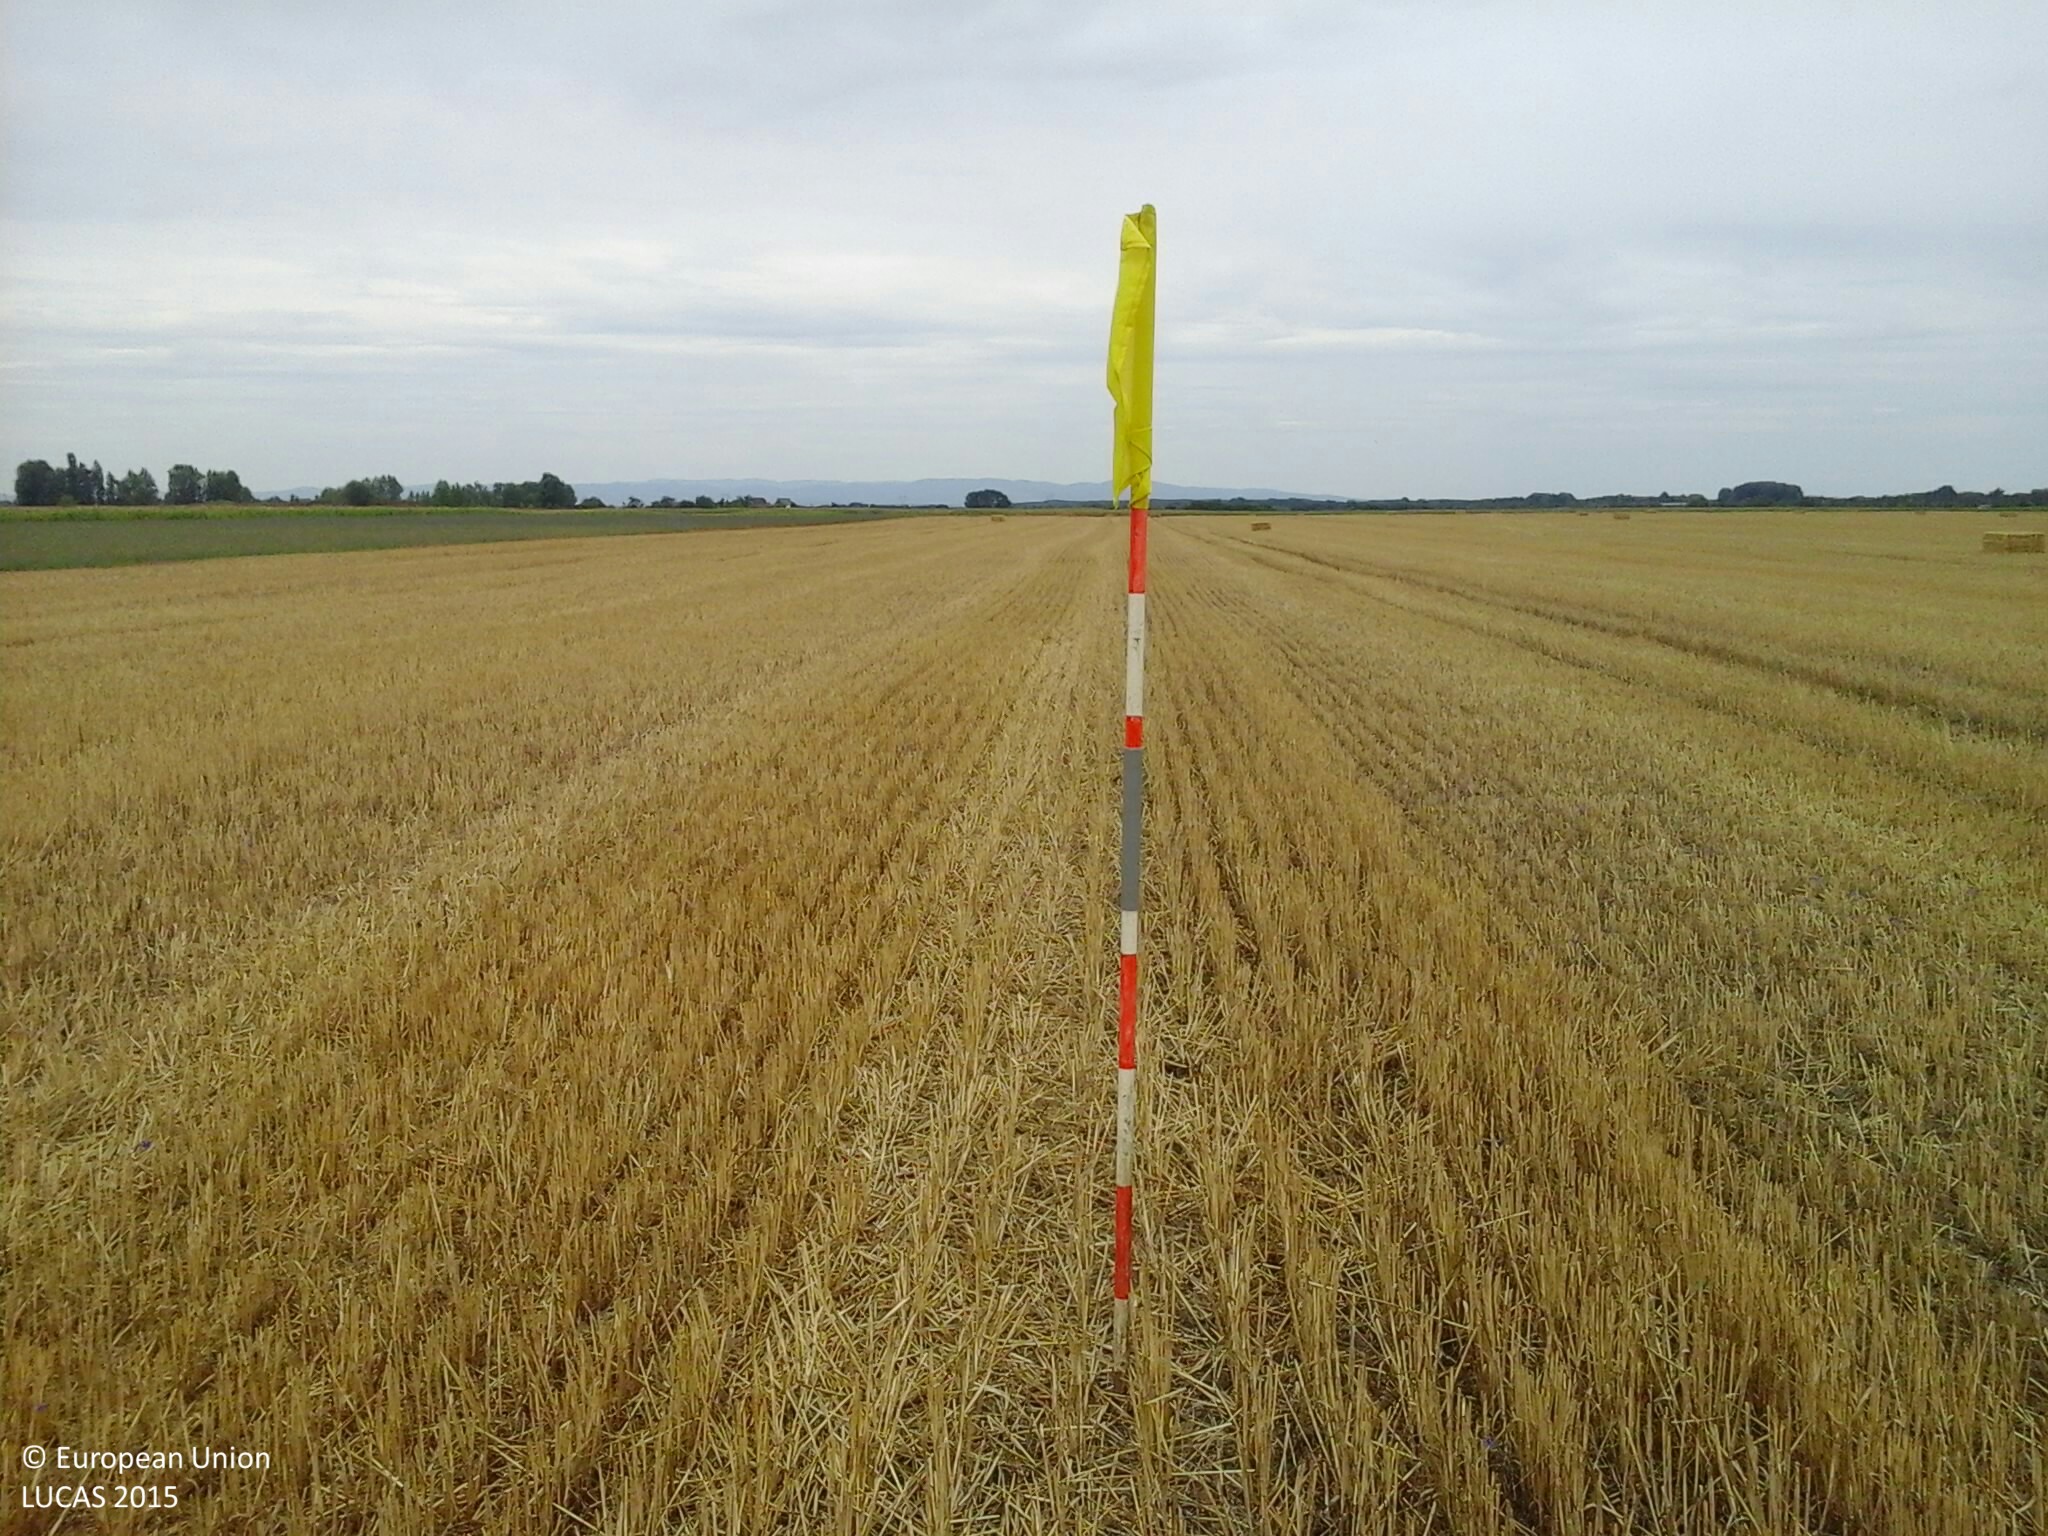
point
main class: Cropland
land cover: Common wheat
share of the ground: > 75 %
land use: Agriculture (excluding fallow land and kitchen gardens)
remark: Harvested field
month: July
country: HU
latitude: 47.8545
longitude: 20.9841
